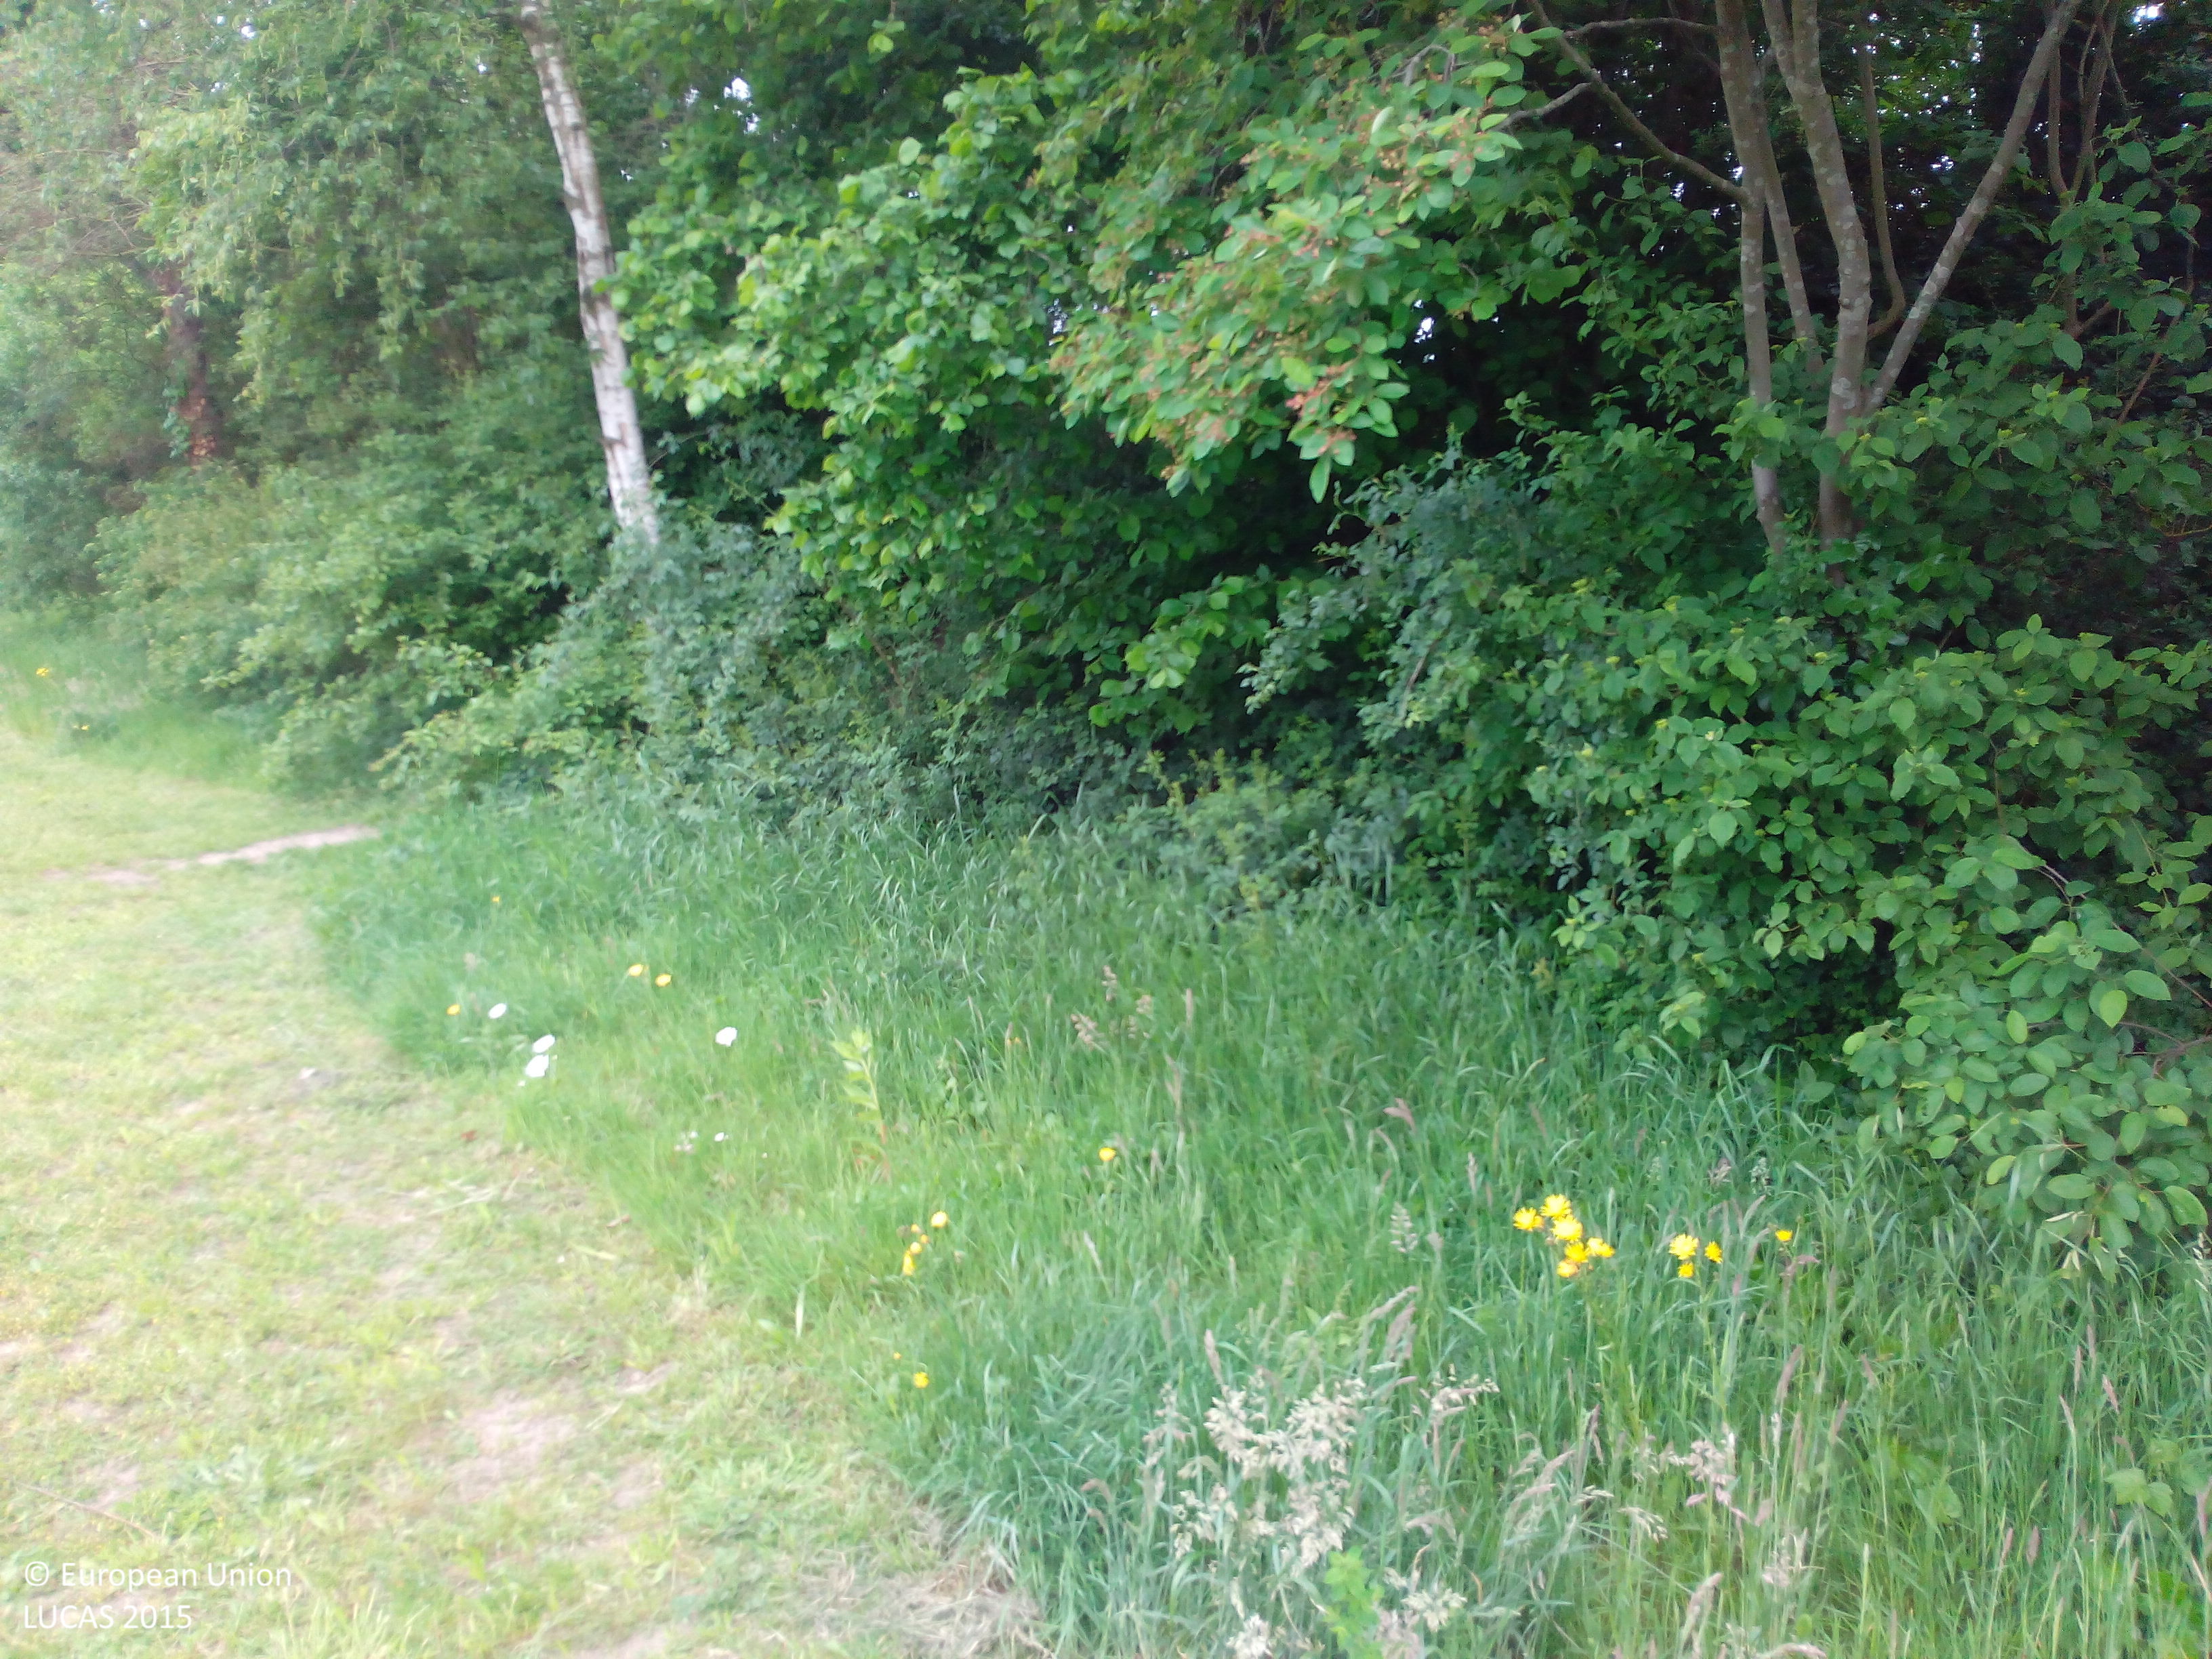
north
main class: Grassland
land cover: Grassland without tree/shrub cover
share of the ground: > 75 %
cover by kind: herbaceous plants 100 %
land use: Road transport
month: May
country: NL
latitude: 52.2449
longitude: 6.2061
